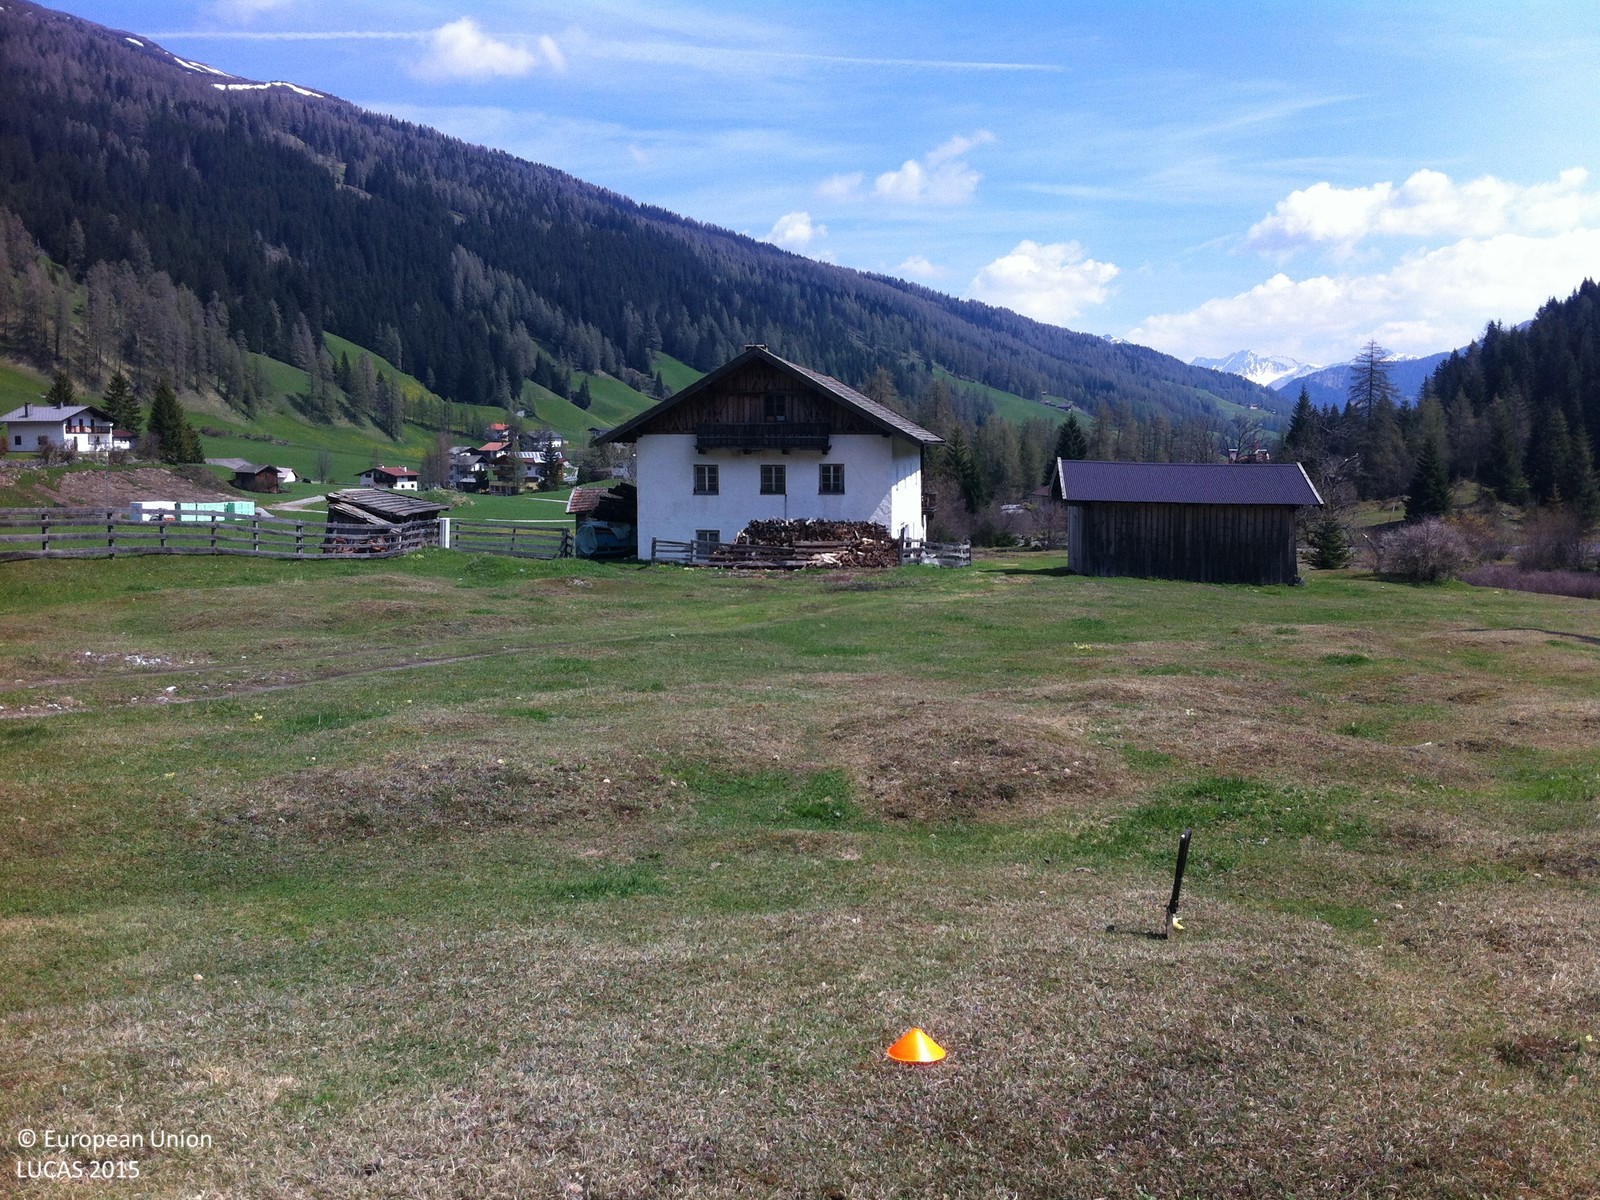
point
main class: Grassland
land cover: Grassland without tree/shrub cover
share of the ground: > 75 %
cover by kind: herbaceous plants 100 %
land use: Agriculture (excluding fallow land and kitchen gardens)
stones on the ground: < 10 %
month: May
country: AT
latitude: 47.0084
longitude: 11.4060
